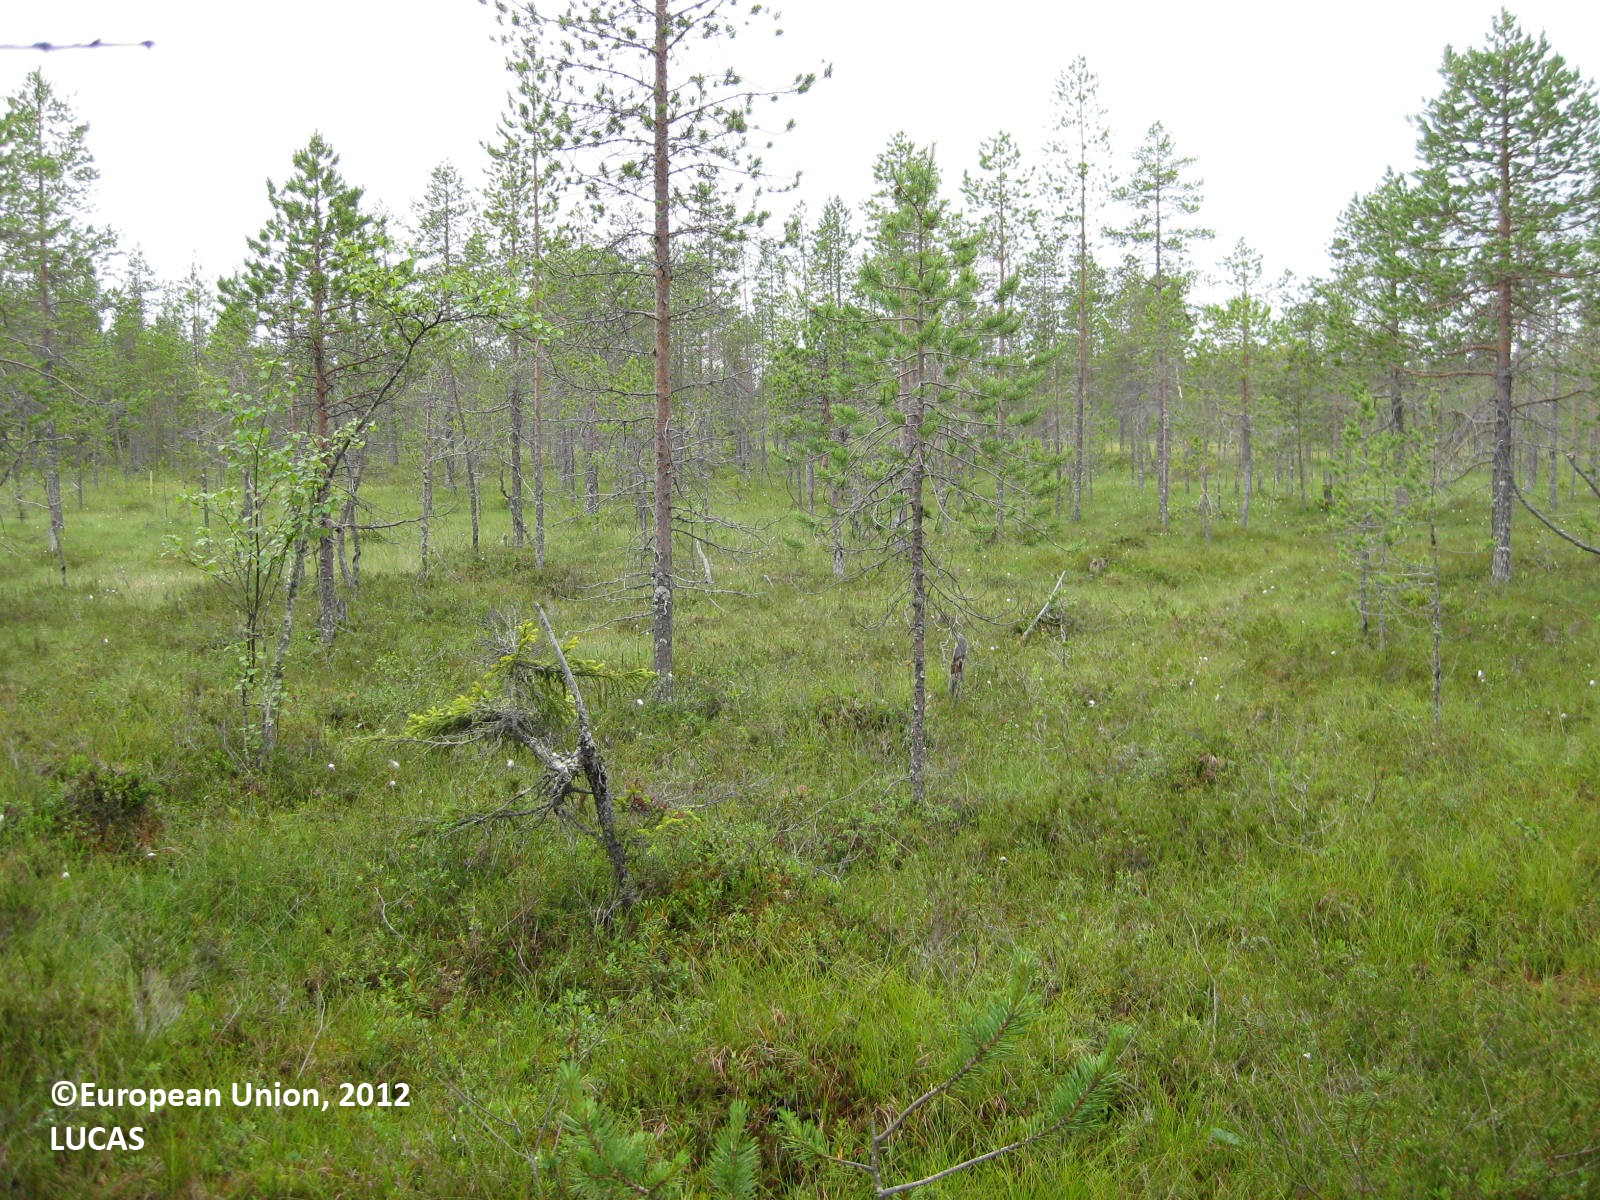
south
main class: Woodland
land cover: Pine dominated coniferous woodland
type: boreal forest
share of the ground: 50 - 75 %
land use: Forestry
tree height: > 5 m
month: July
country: FI
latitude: 65.8597
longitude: 29.5891
